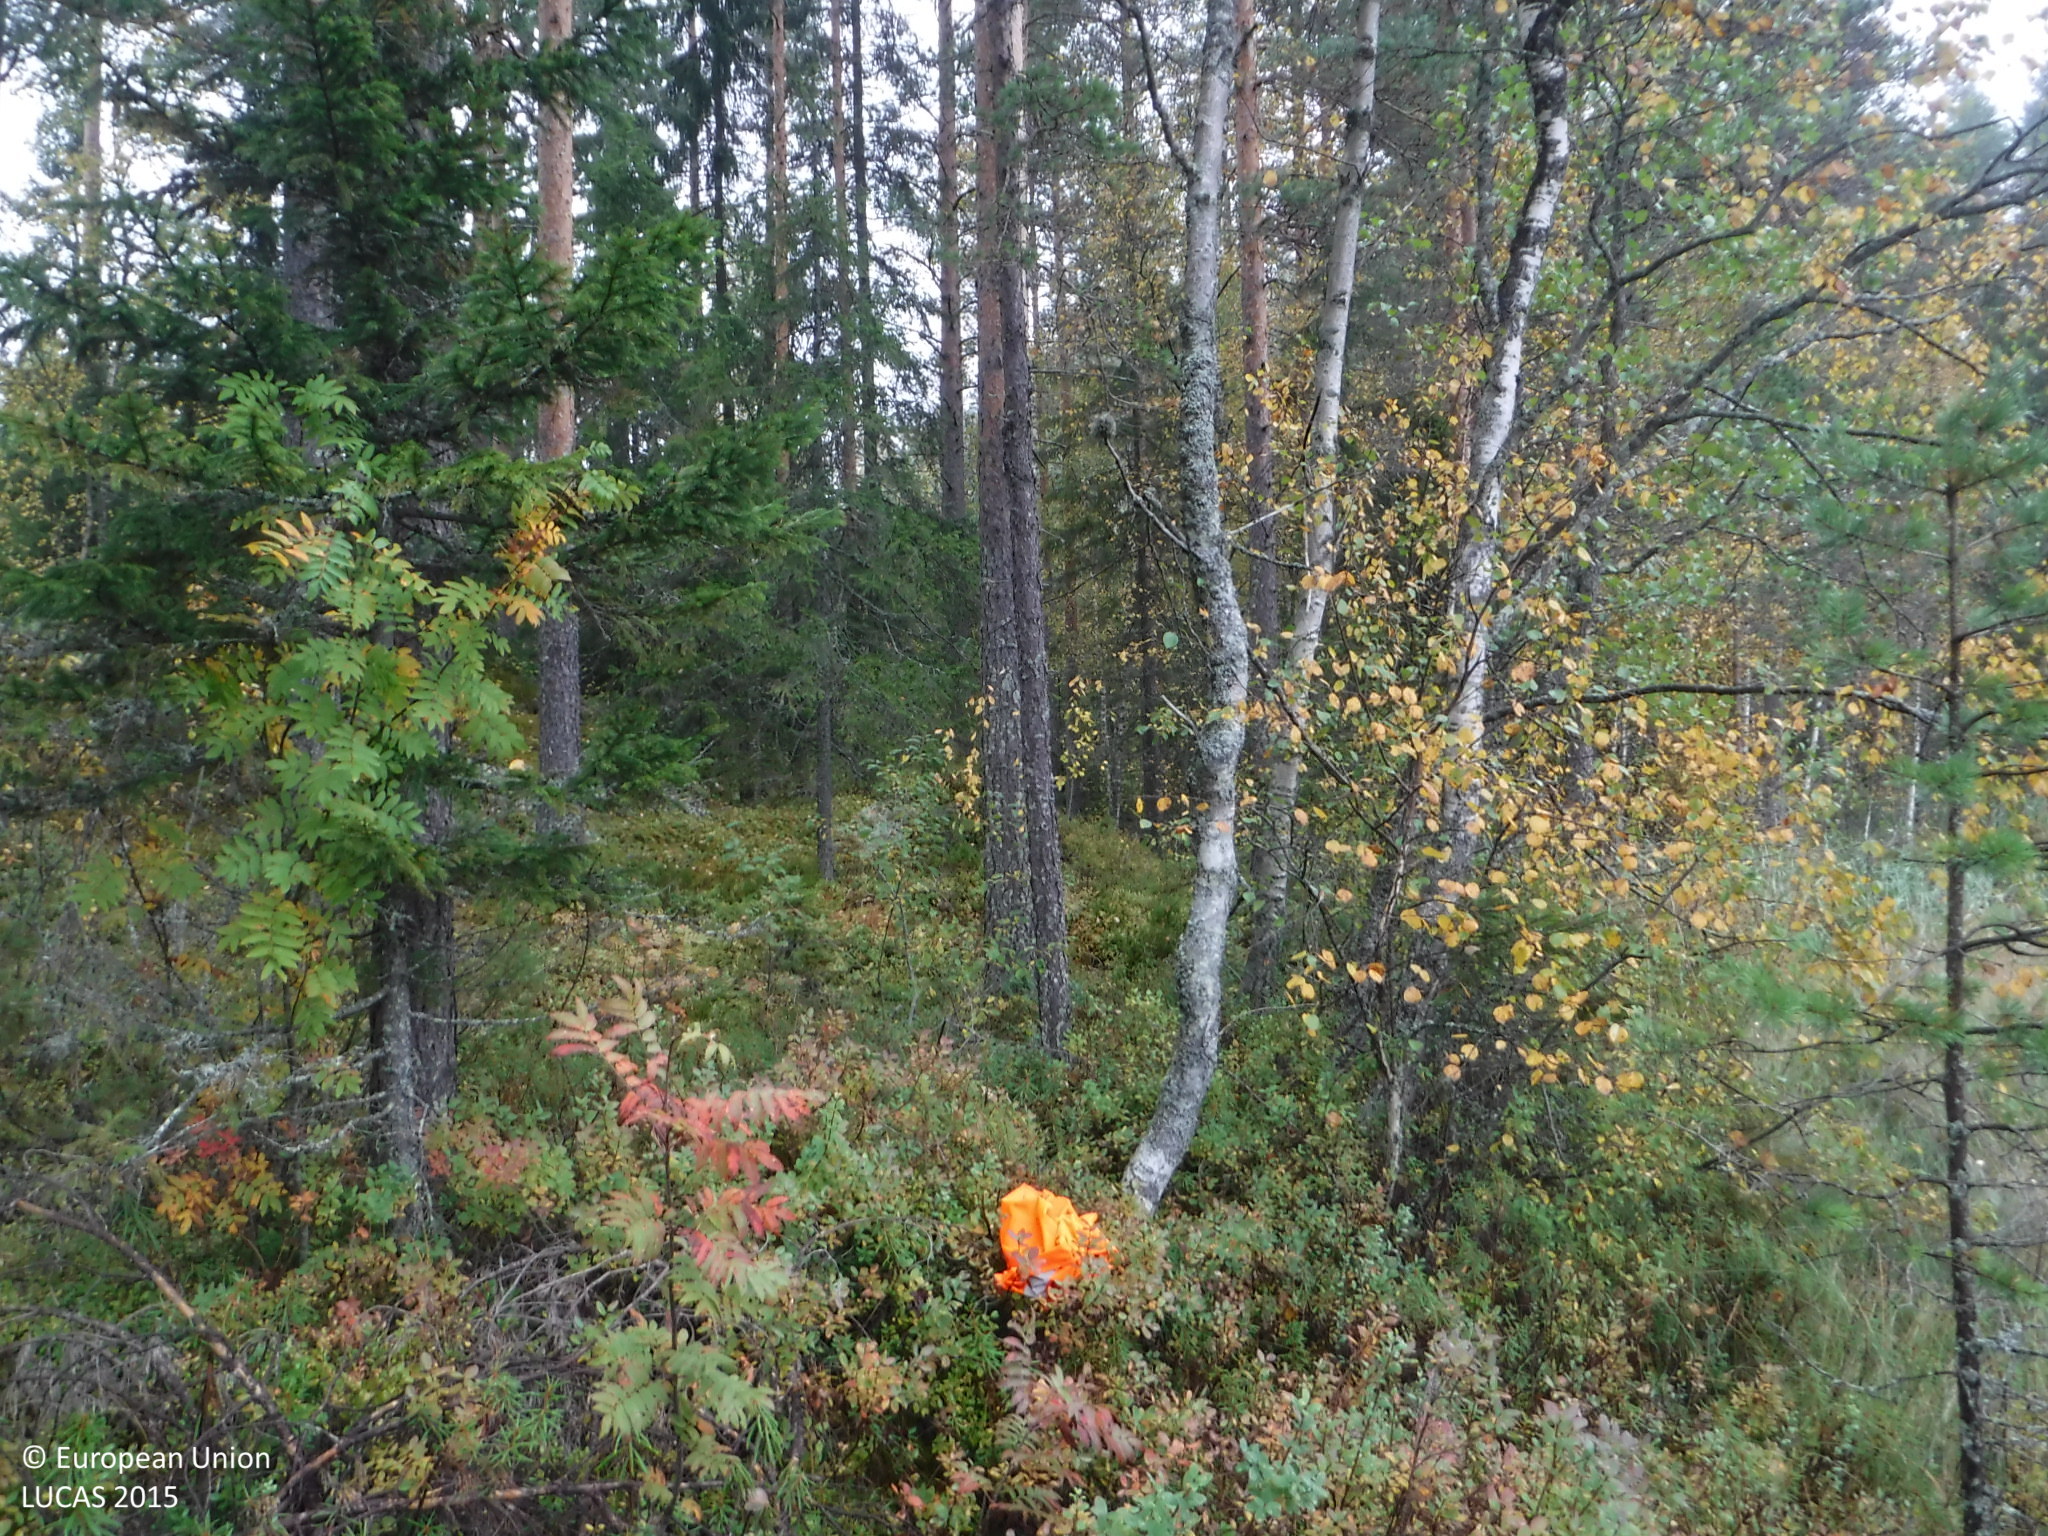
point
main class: Woodland
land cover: Other coniferous woodland
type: boreal forest
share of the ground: 50 - 75 %
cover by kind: coniferous forest trees 60 %, shrubs 30 %, broadleaved forest trees 5 %, lichens and mosses 5 %
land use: Forestry
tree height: > 5 m
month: September
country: FI
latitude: 61.8036
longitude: 24.2244
